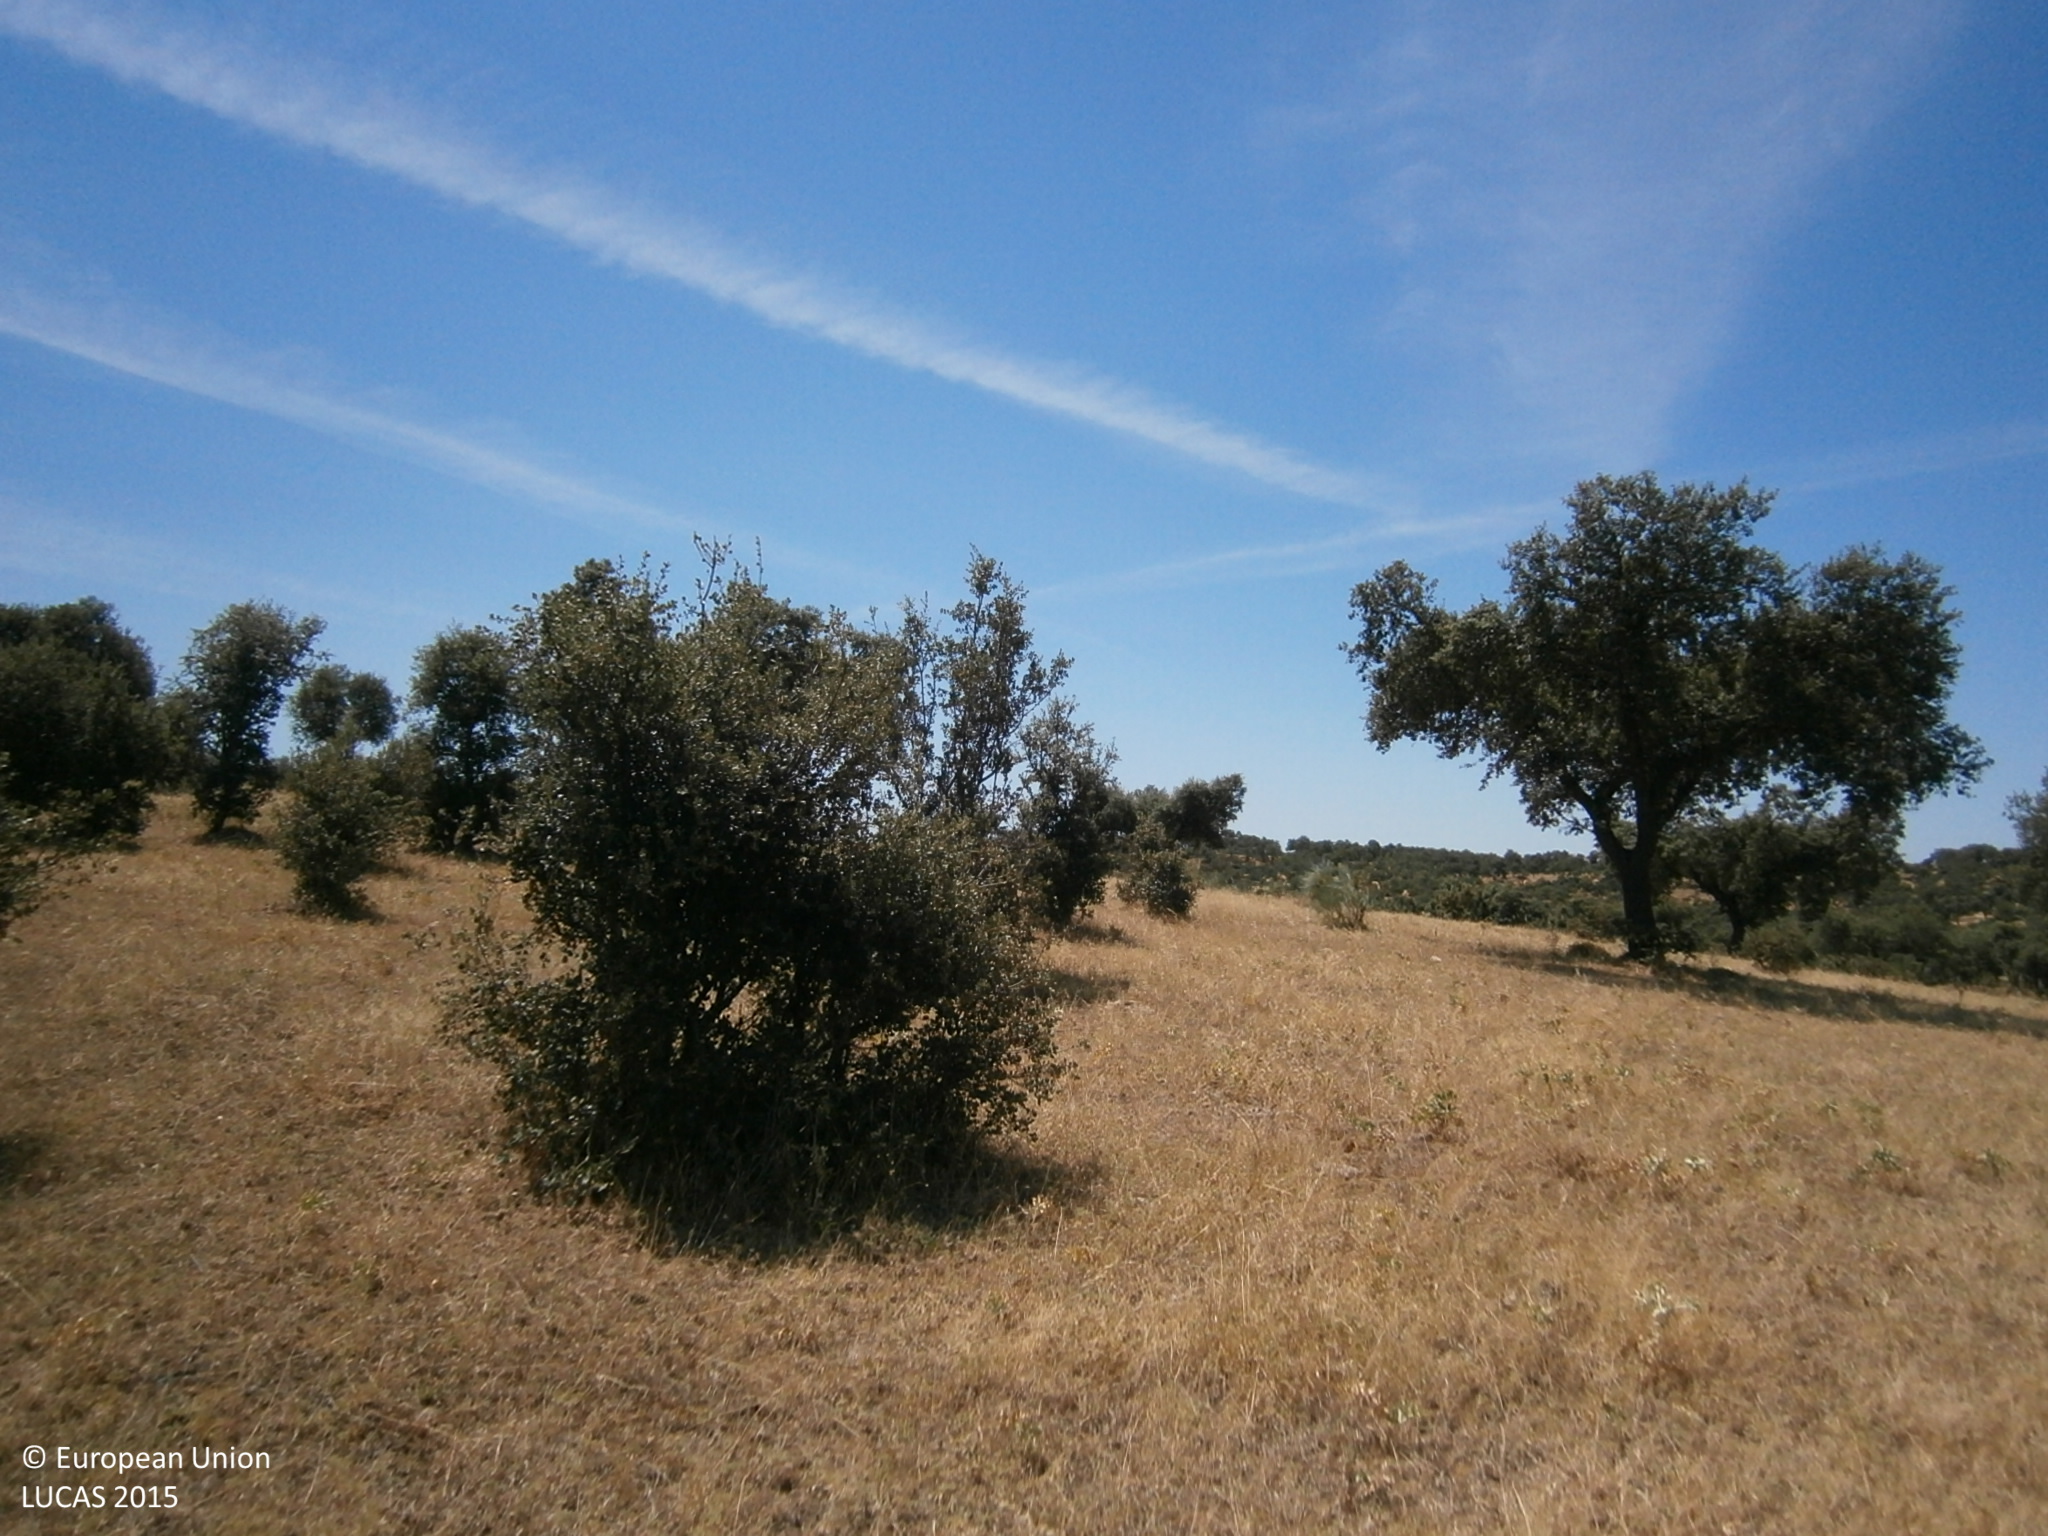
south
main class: Grassland
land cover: Grassland with sparse tree/shrub cover
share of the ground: > 75 %
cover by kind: herbaceous plants 90 %, broadleaved forest trees 5 %, shrubs 5 %
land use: Agriculture (excluding fallow land and kitchen gardens)
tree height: > 5 m
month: July
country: ES
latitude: 38.6430
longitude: -7.2008
